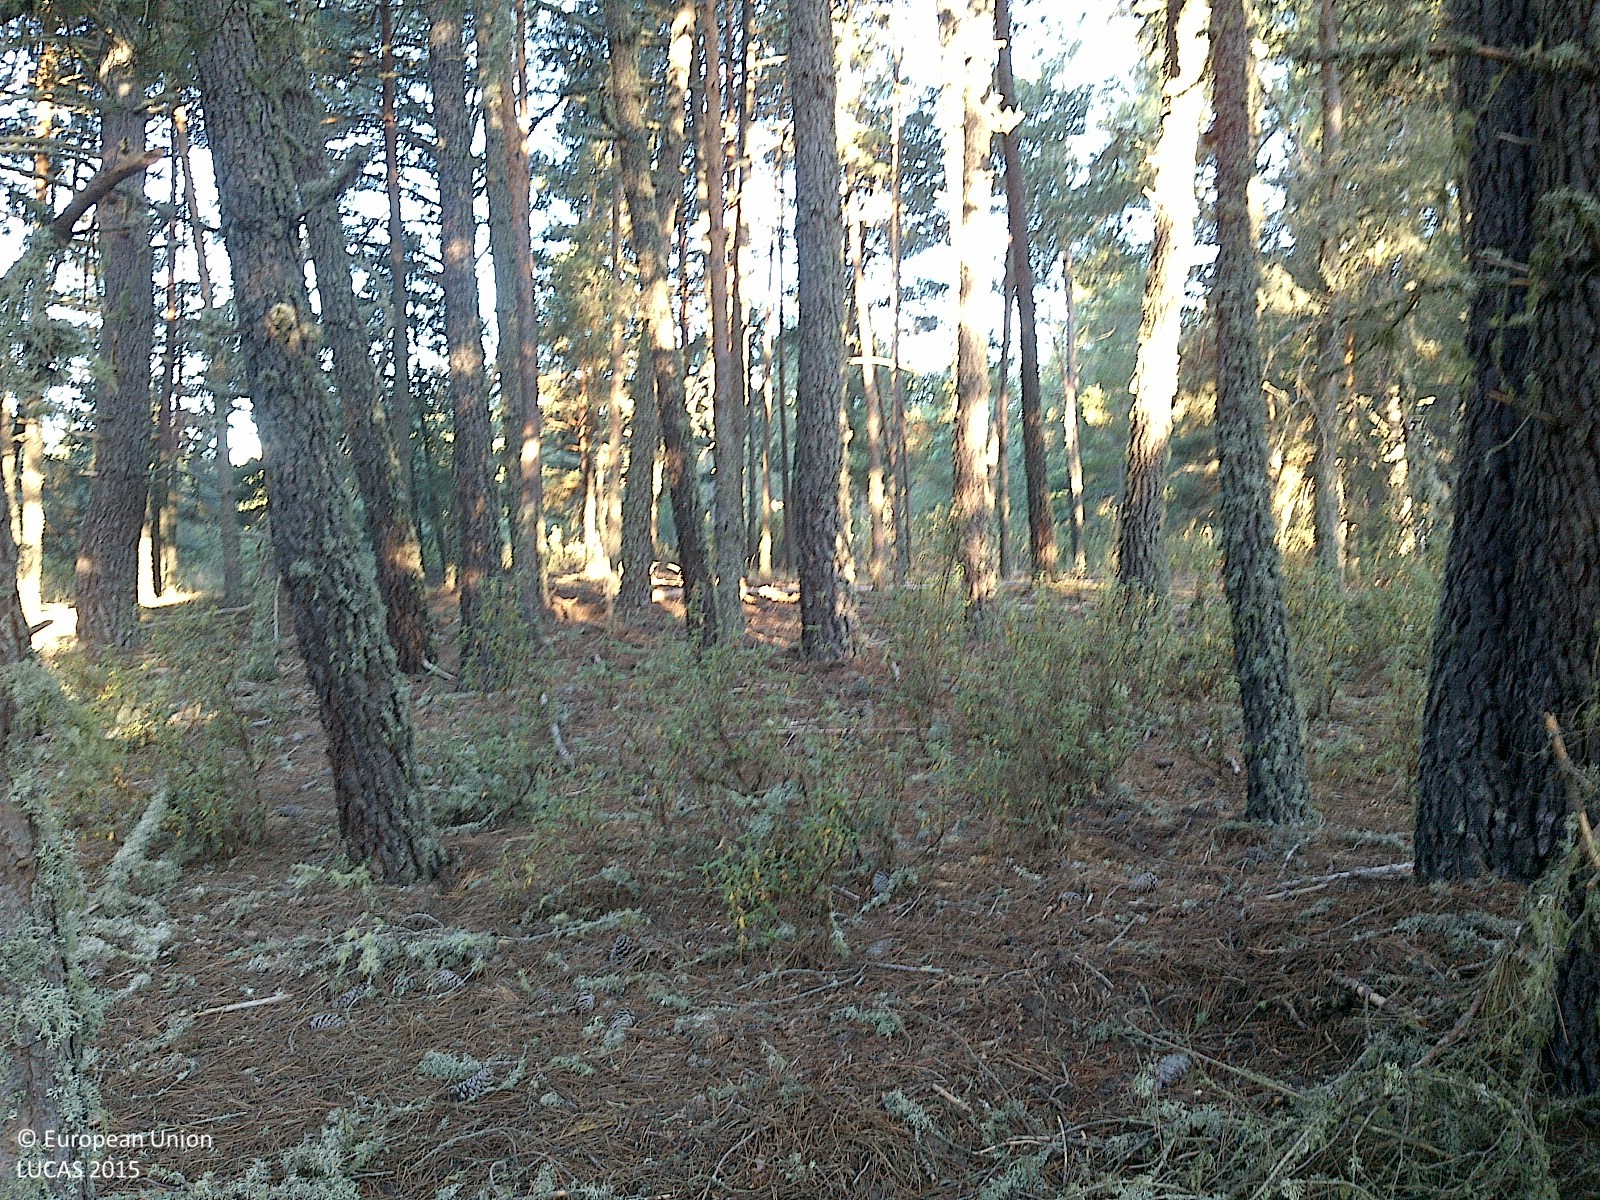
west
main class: Woodland
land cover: Pine dominated coniferous woodland
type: coniferous forest of the mediterranean region
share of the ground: > 75 %
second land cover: Grassland without tree/shrub cover
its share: 10 - 25 %
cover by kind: coniferous forest trees 80 %, herbaceous plants 10 %, shrubs 5 %, lichens and mosses 5 %
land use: Forestry
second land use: Agriculture (excluding fallow land and kitchen gardens)
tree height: > 5 m
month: July
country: ES
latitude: 41.8519
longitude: -3.1156
